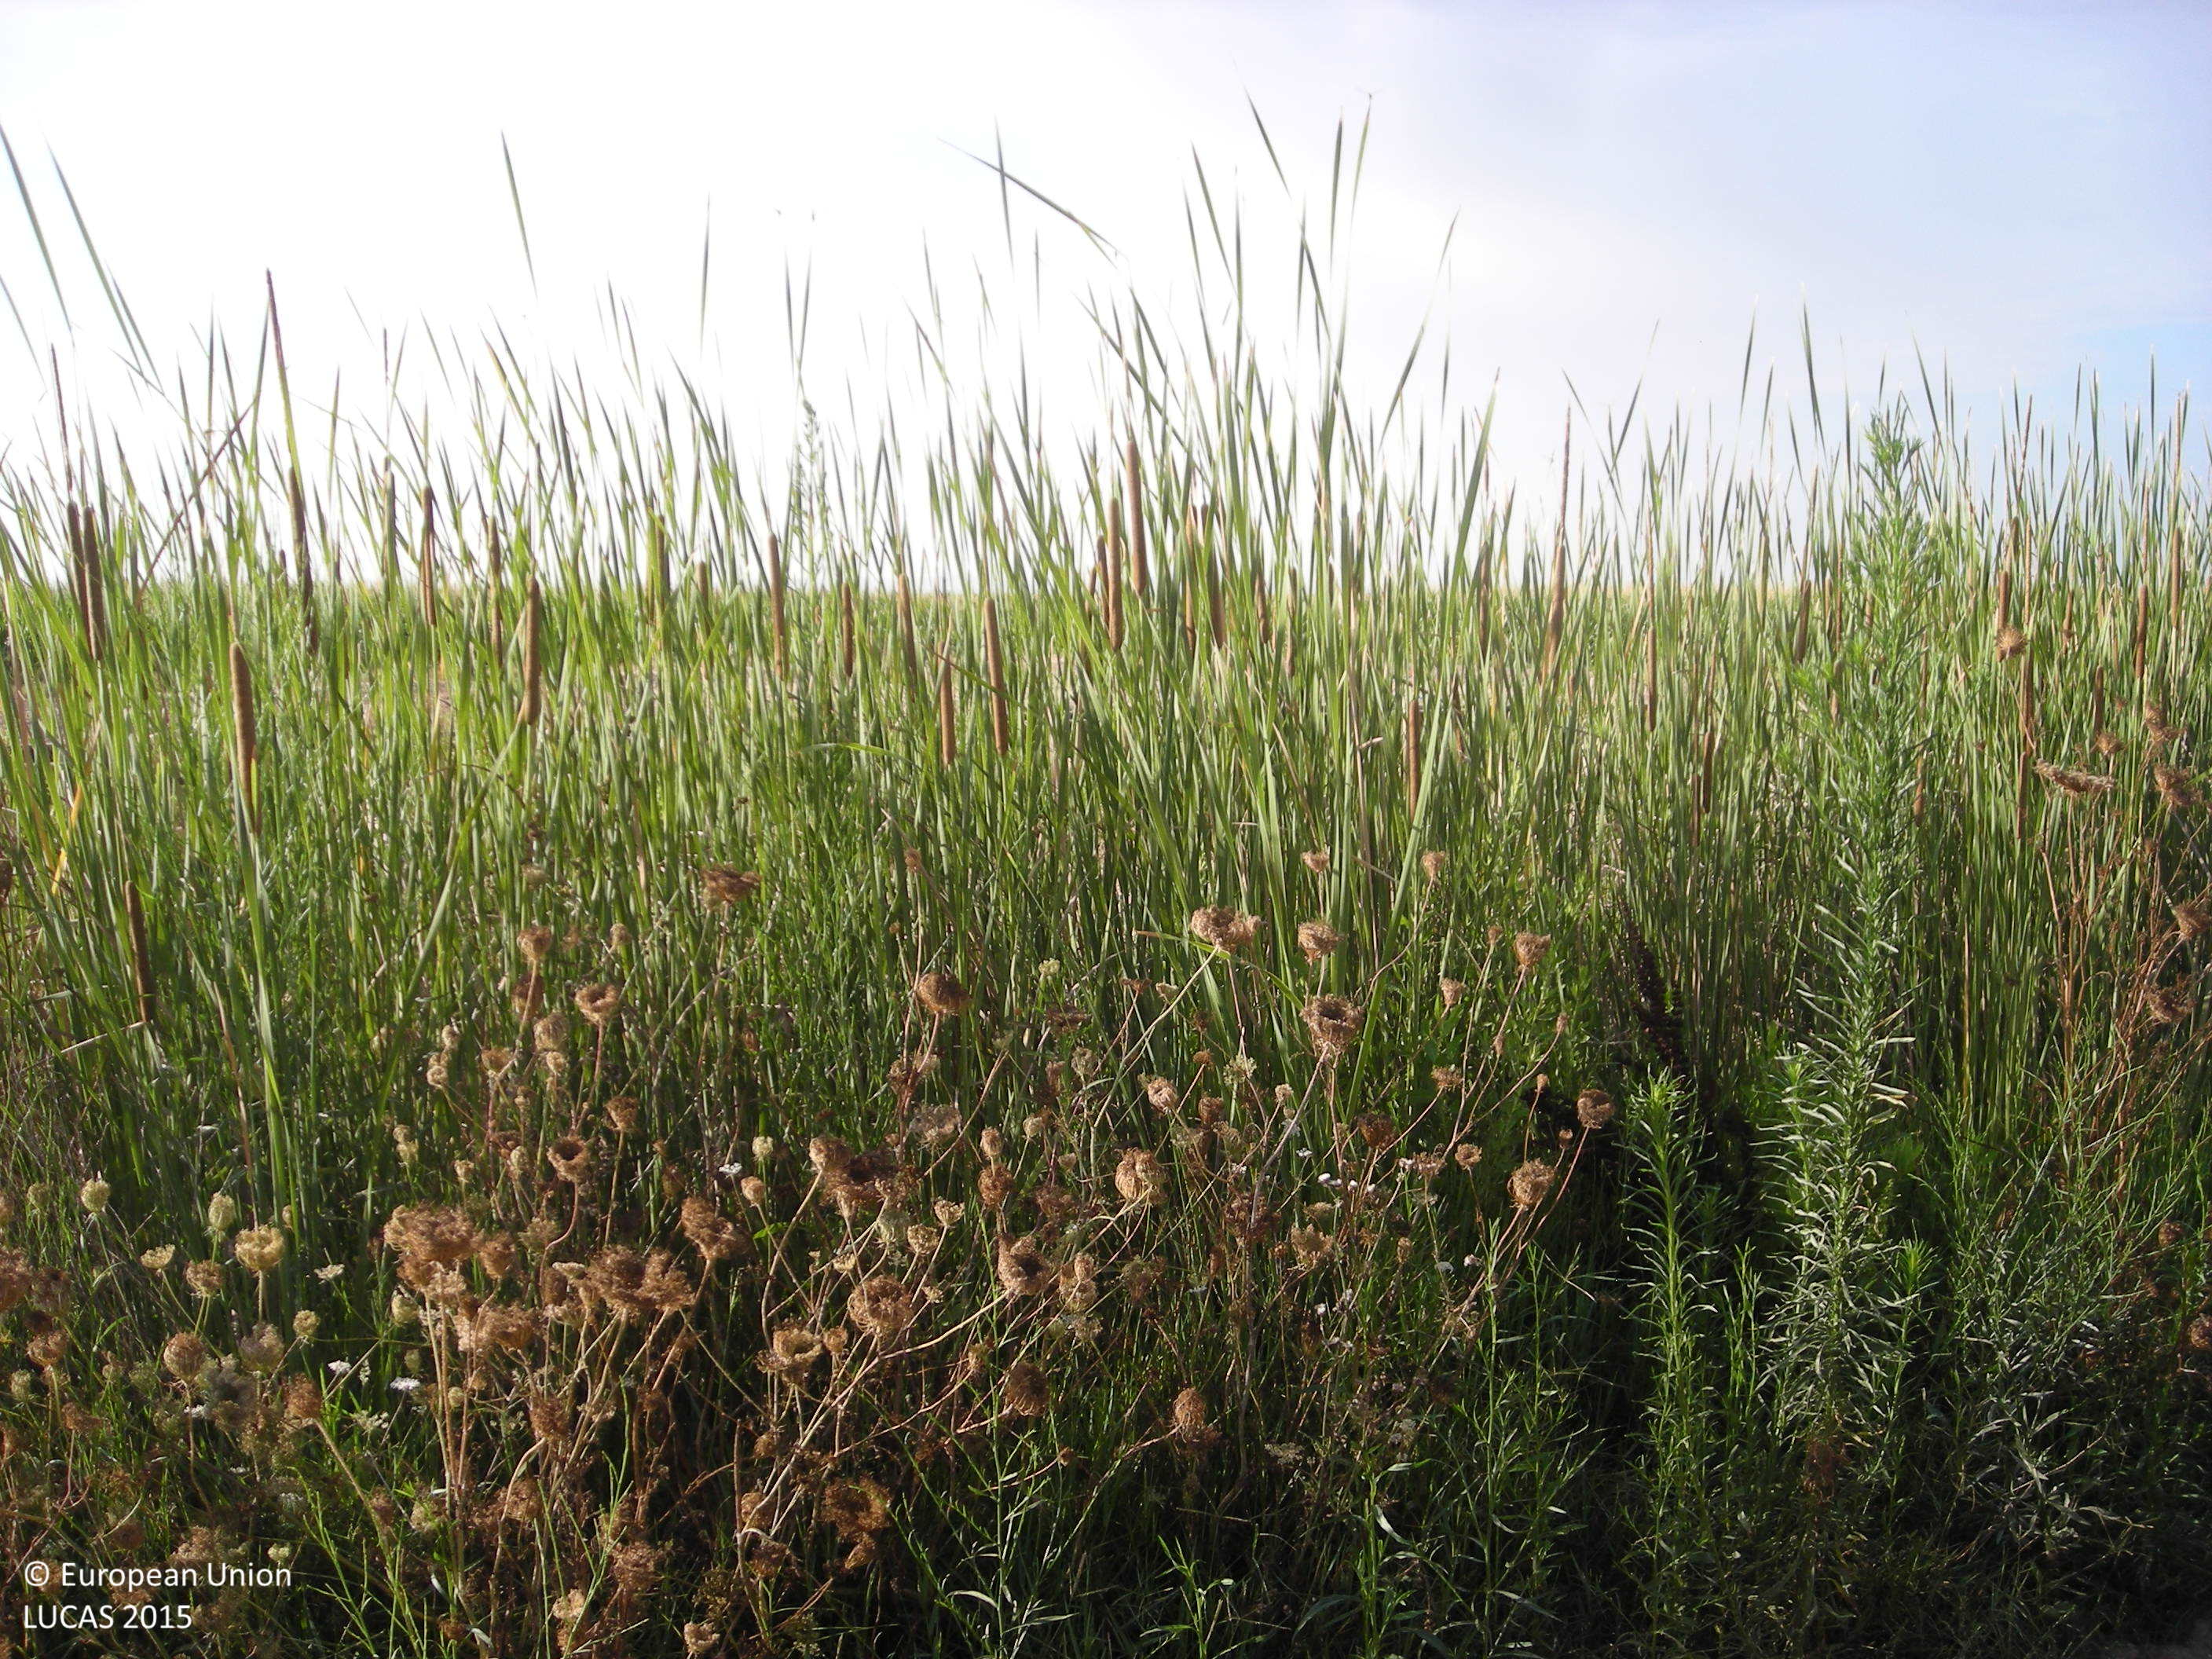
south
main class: Cropland
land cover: Maize
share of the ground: > 75 %
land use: Agriculture (excluding fallow land and kitchen gardens)
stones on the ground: < 10 %
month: July
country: ES
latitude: 39.1213
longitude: -5.9342
